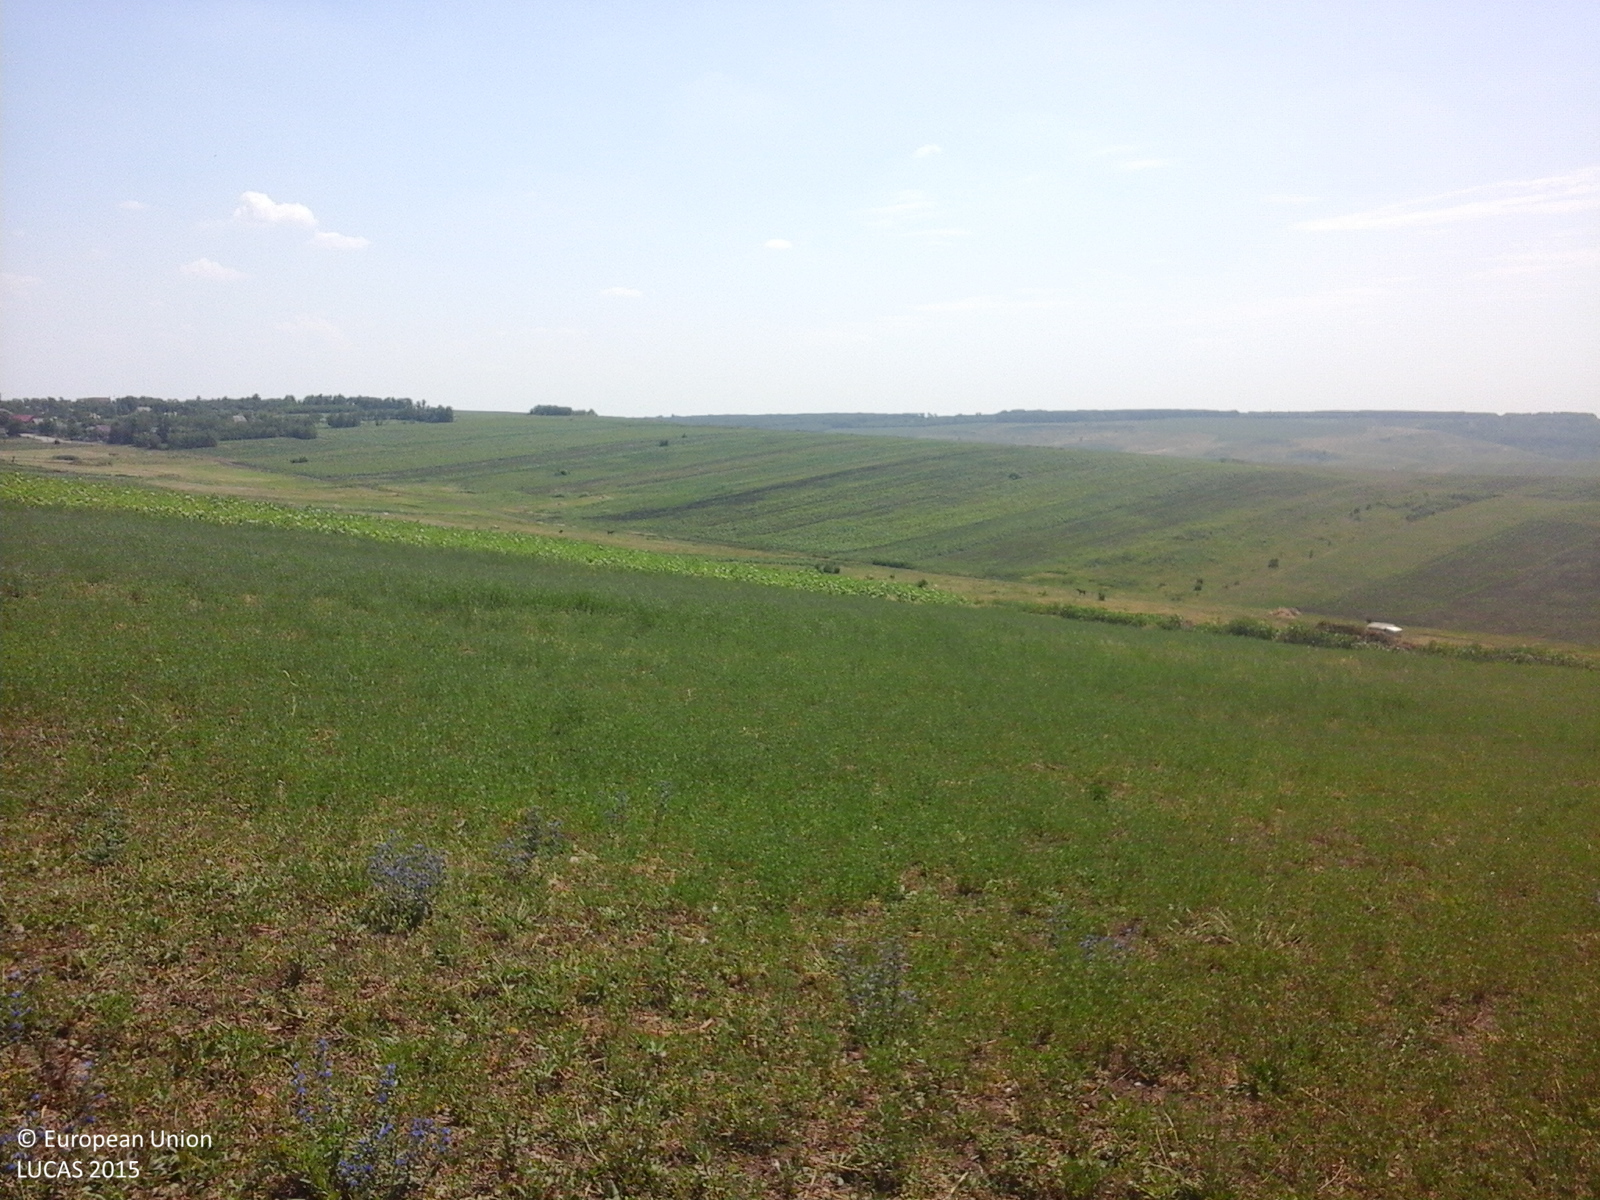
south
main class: Cropland
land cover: Lucerne
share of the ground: 50 - 75 %
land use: Agriculture (excluding fallow land and kitchen gardens)
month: June
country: RO
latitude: 47.4328
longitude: 27.1713
